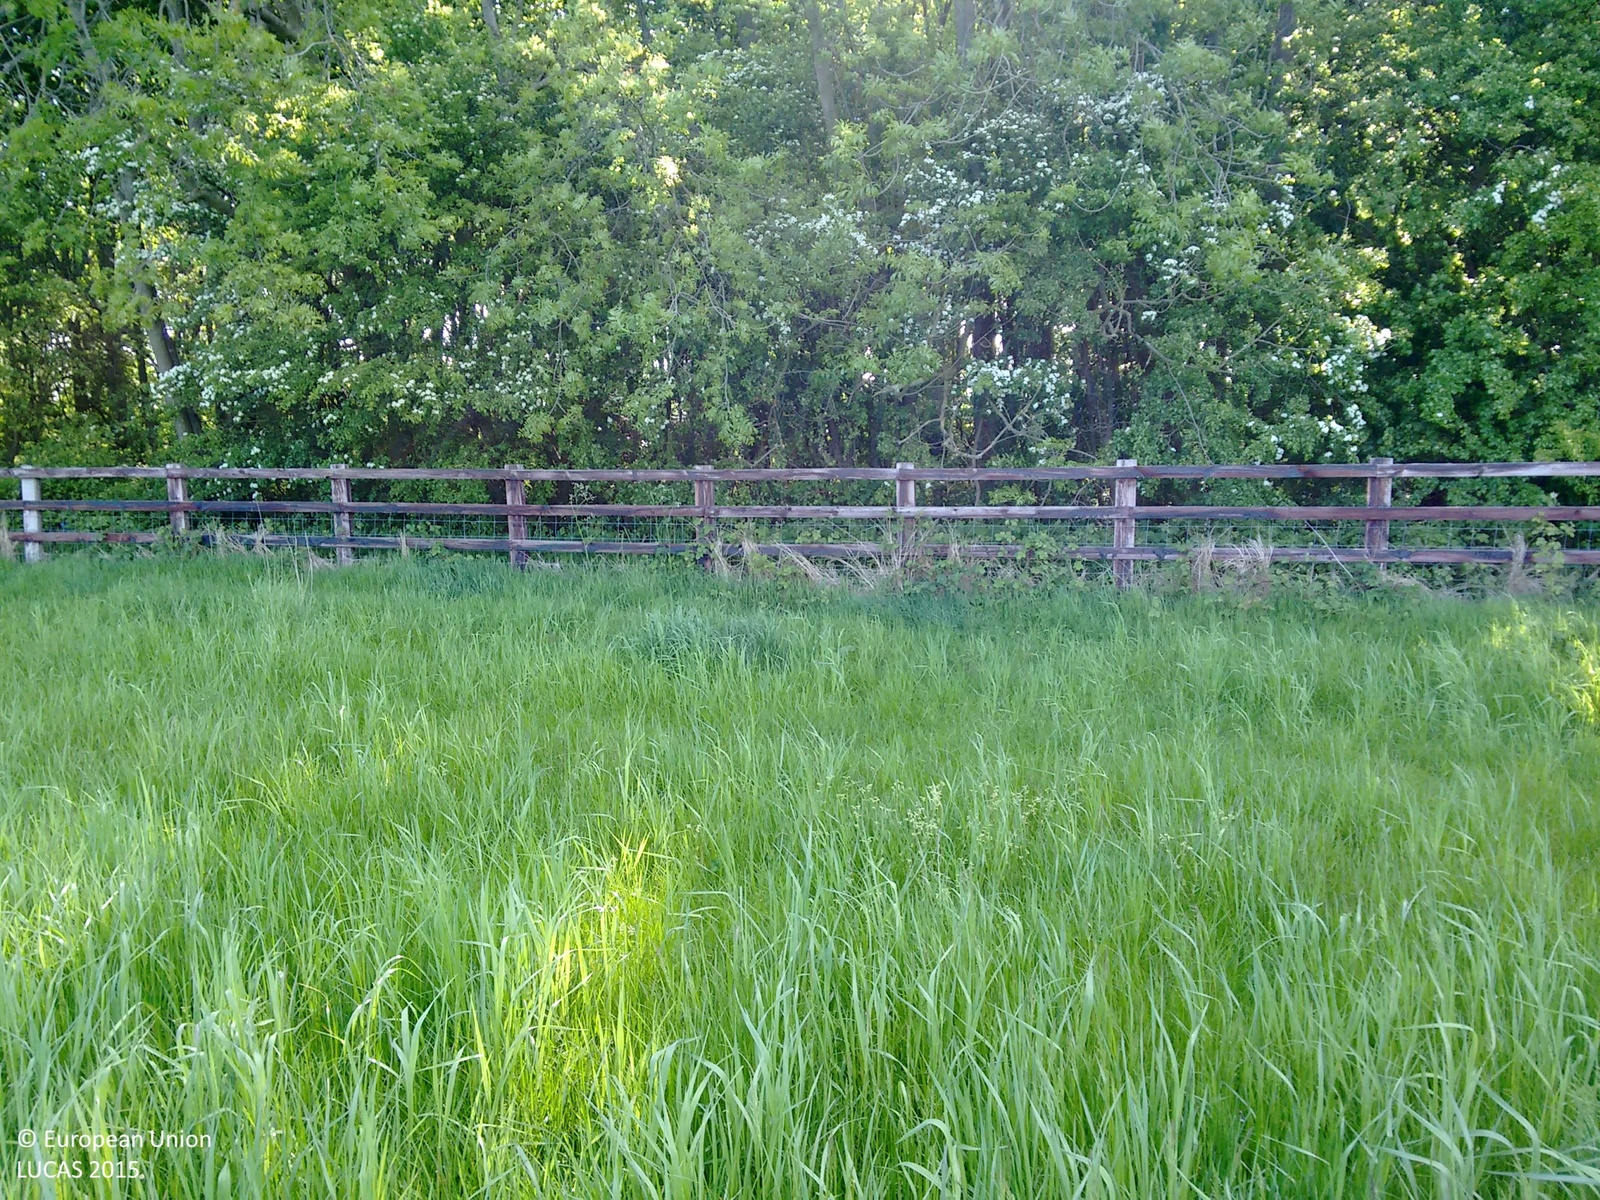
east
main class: Grassland
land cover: Grassland without tree/shrub cover
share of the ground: > 75 %
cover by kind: herbaceous plants 100 %
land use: Agriculture (excluding fallow land and kitchen gardens)
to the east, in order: Grassland without tree/shrub cover; Fences; Broadleaved woodland; Ditches and canals; Broadleaved woodland; Tracks; Broadleaved woodland; Common wheat
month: May
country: GB
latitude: 53.5966
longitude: -0.2943
